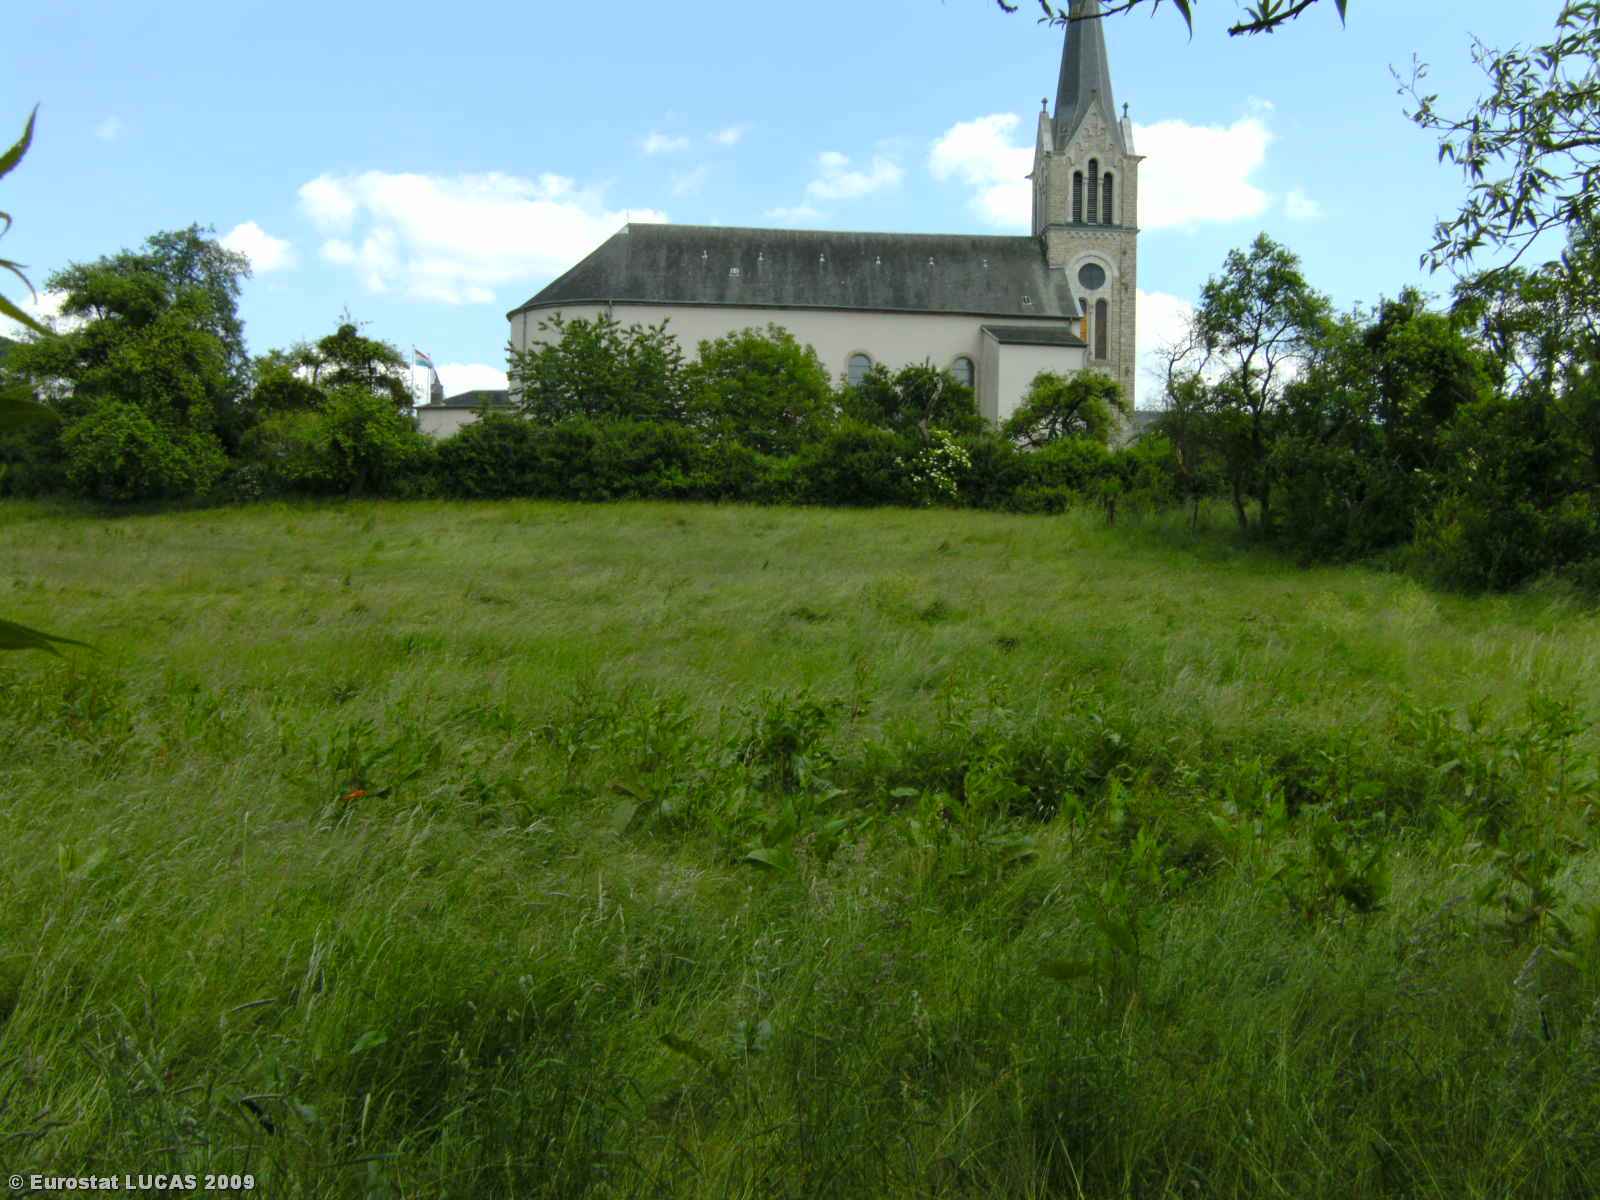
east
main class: Woodland
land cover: Broadleaved woodland
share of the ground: 10 - 25 %
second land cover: Grassland with sparse tree/shrub cover
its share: > 75 %
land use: Agriculture (excluding fallow land and kitchen gardens)
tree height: > 5 m
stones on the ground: < 10 %
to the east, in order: Broadleaved woodland; Grassland without tree/shrub cover; Broadleaved woodland; Grassland with sparse tree/shrub cover; Apple fruit; Dry stone walls; Artificial constructions in urban areas
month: June
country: LU
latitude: 49.6562
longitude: 6.3010
